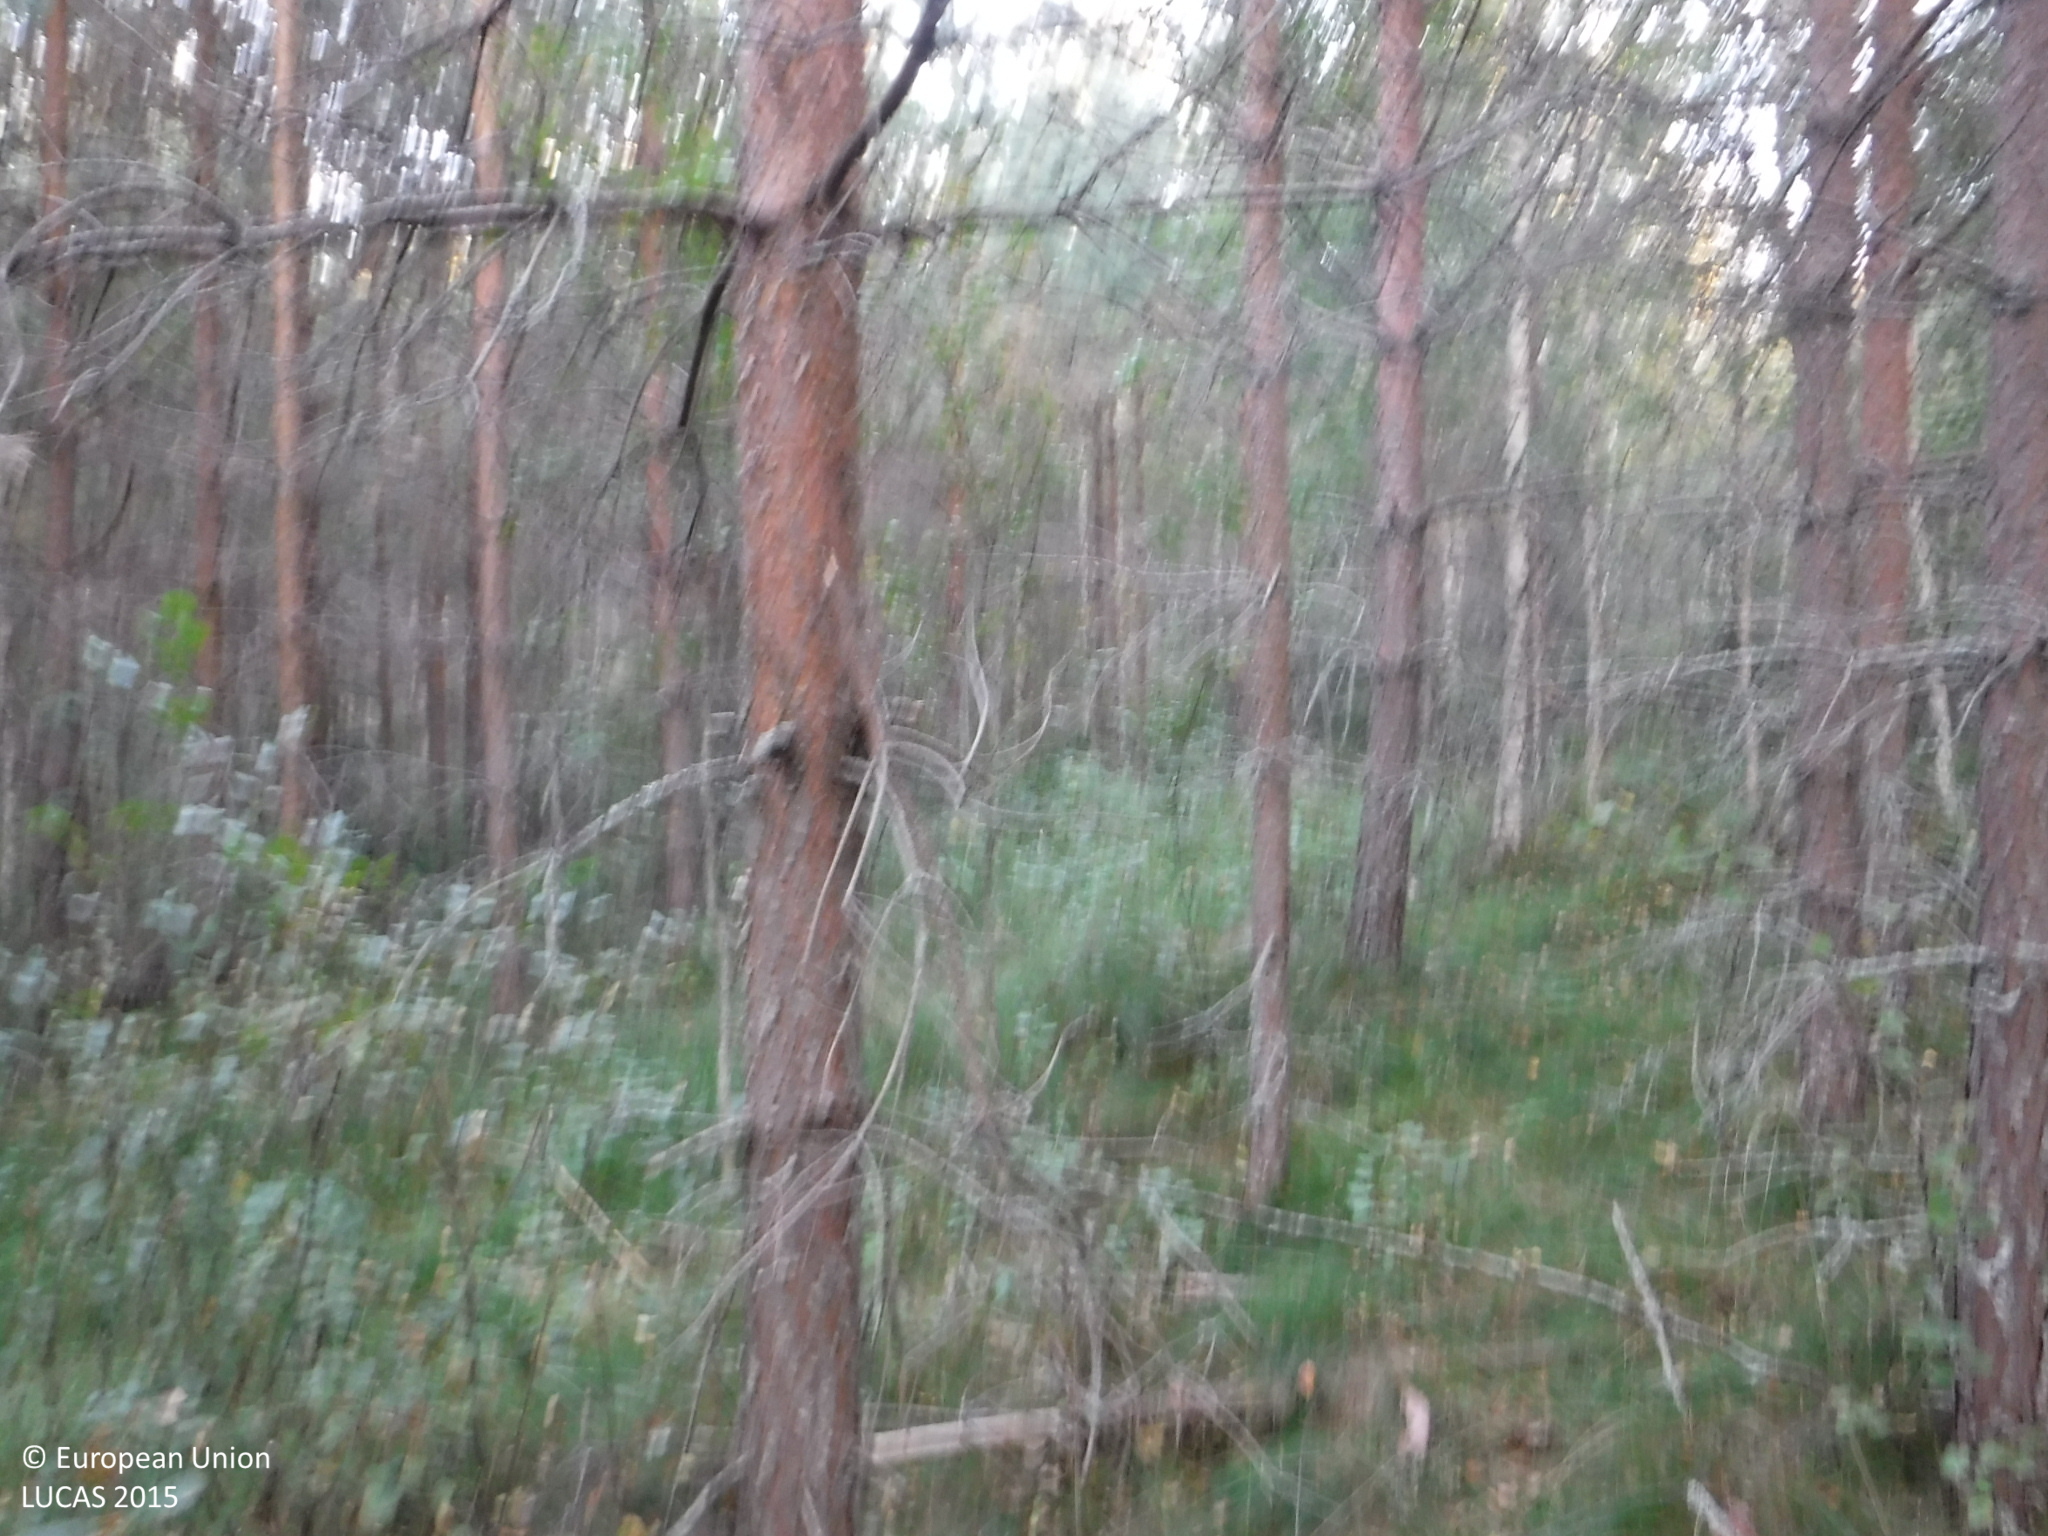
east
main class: Woodland
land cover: Pine dominated mixed woodland
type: boreal forest
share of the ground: > 75 %
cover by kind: coniferous forest trees 40 %, broadleaved forest trees 40 %, herbaceous plants 20 %
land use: Forestry
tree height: > 5 m
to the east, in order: Pine dominated mixed woodland; Spruce dominated coniferous woodland; Shrubland with sparse tree cover; Spruce dominated coniferous woodland; Groves; Ditches and canals; Grass margins; Tracks
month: August
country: FI
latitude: 61.1467
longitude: 23.0218
